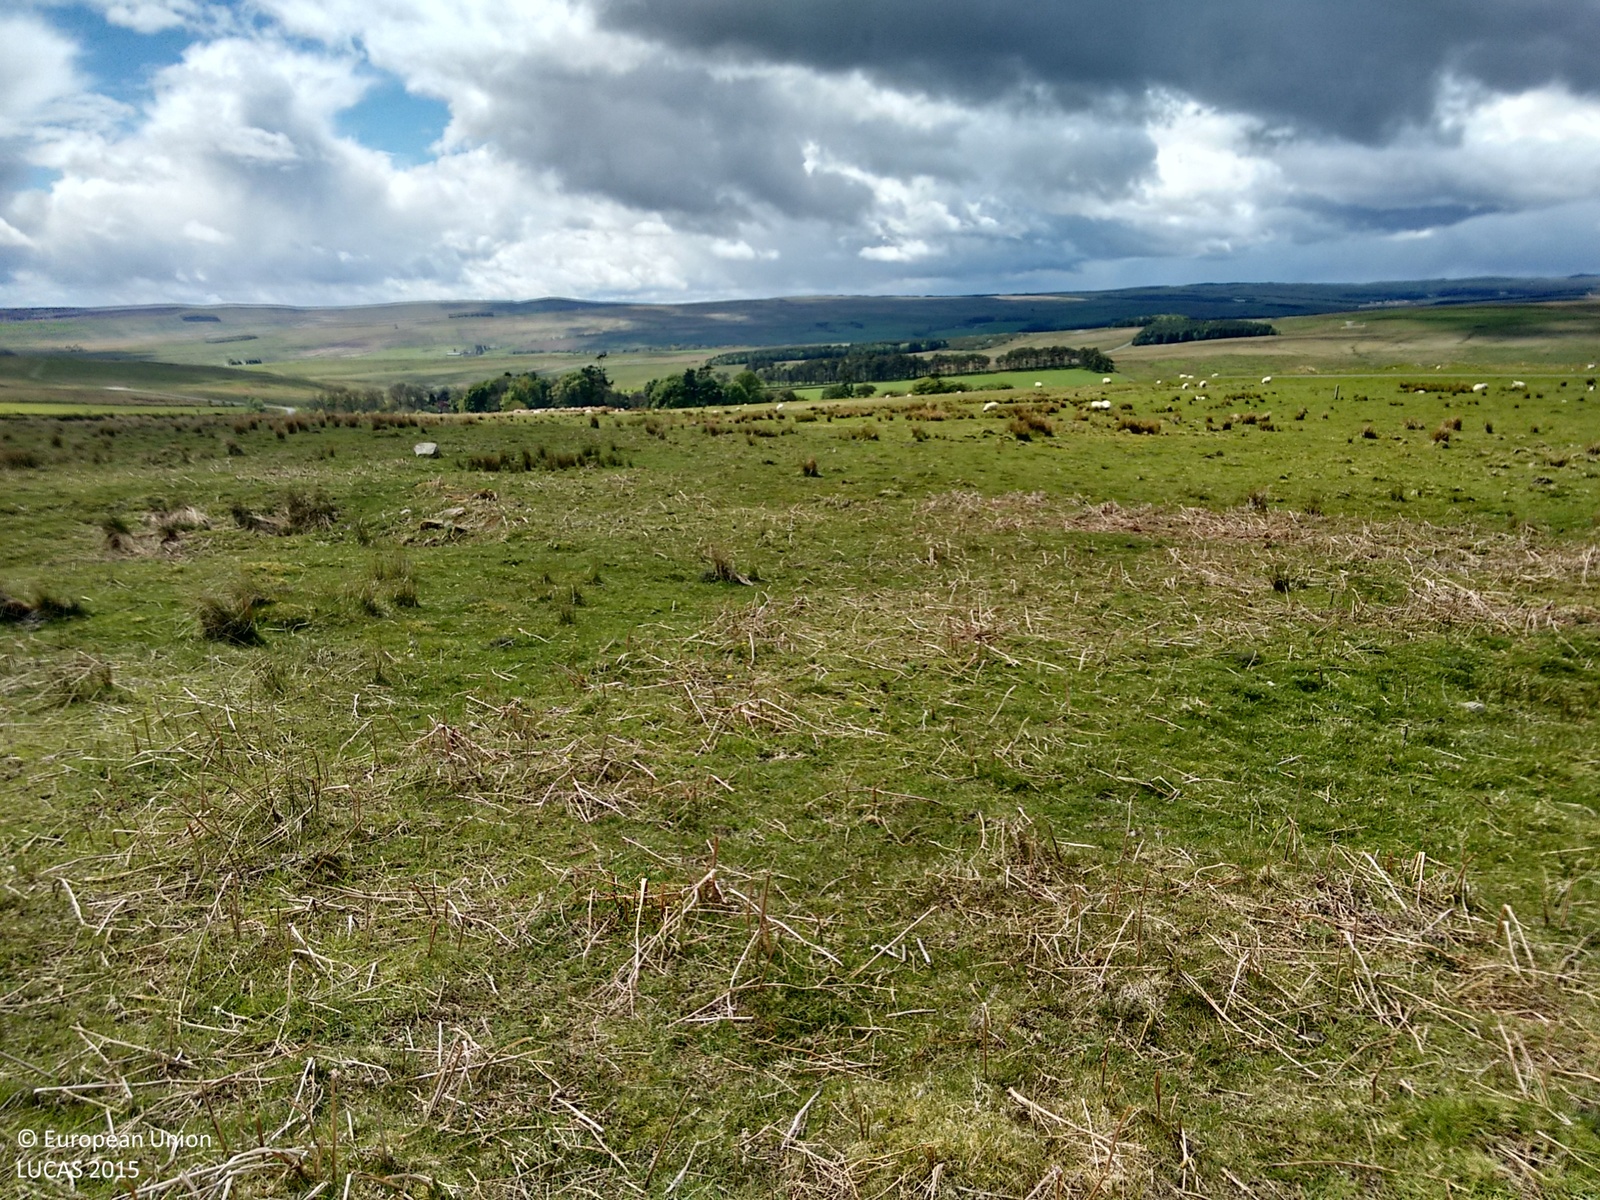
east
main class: Grassland
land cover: Grassland without tree/shrub cover
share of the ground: > 75 %
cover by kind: herbaceous plants 100 %
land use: Agriculture (excluding fallow land and kitchen gardens)
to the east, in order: Grassland without tree/shrub cover
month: May
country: GB
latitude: 55.2759
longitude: -2.1933
